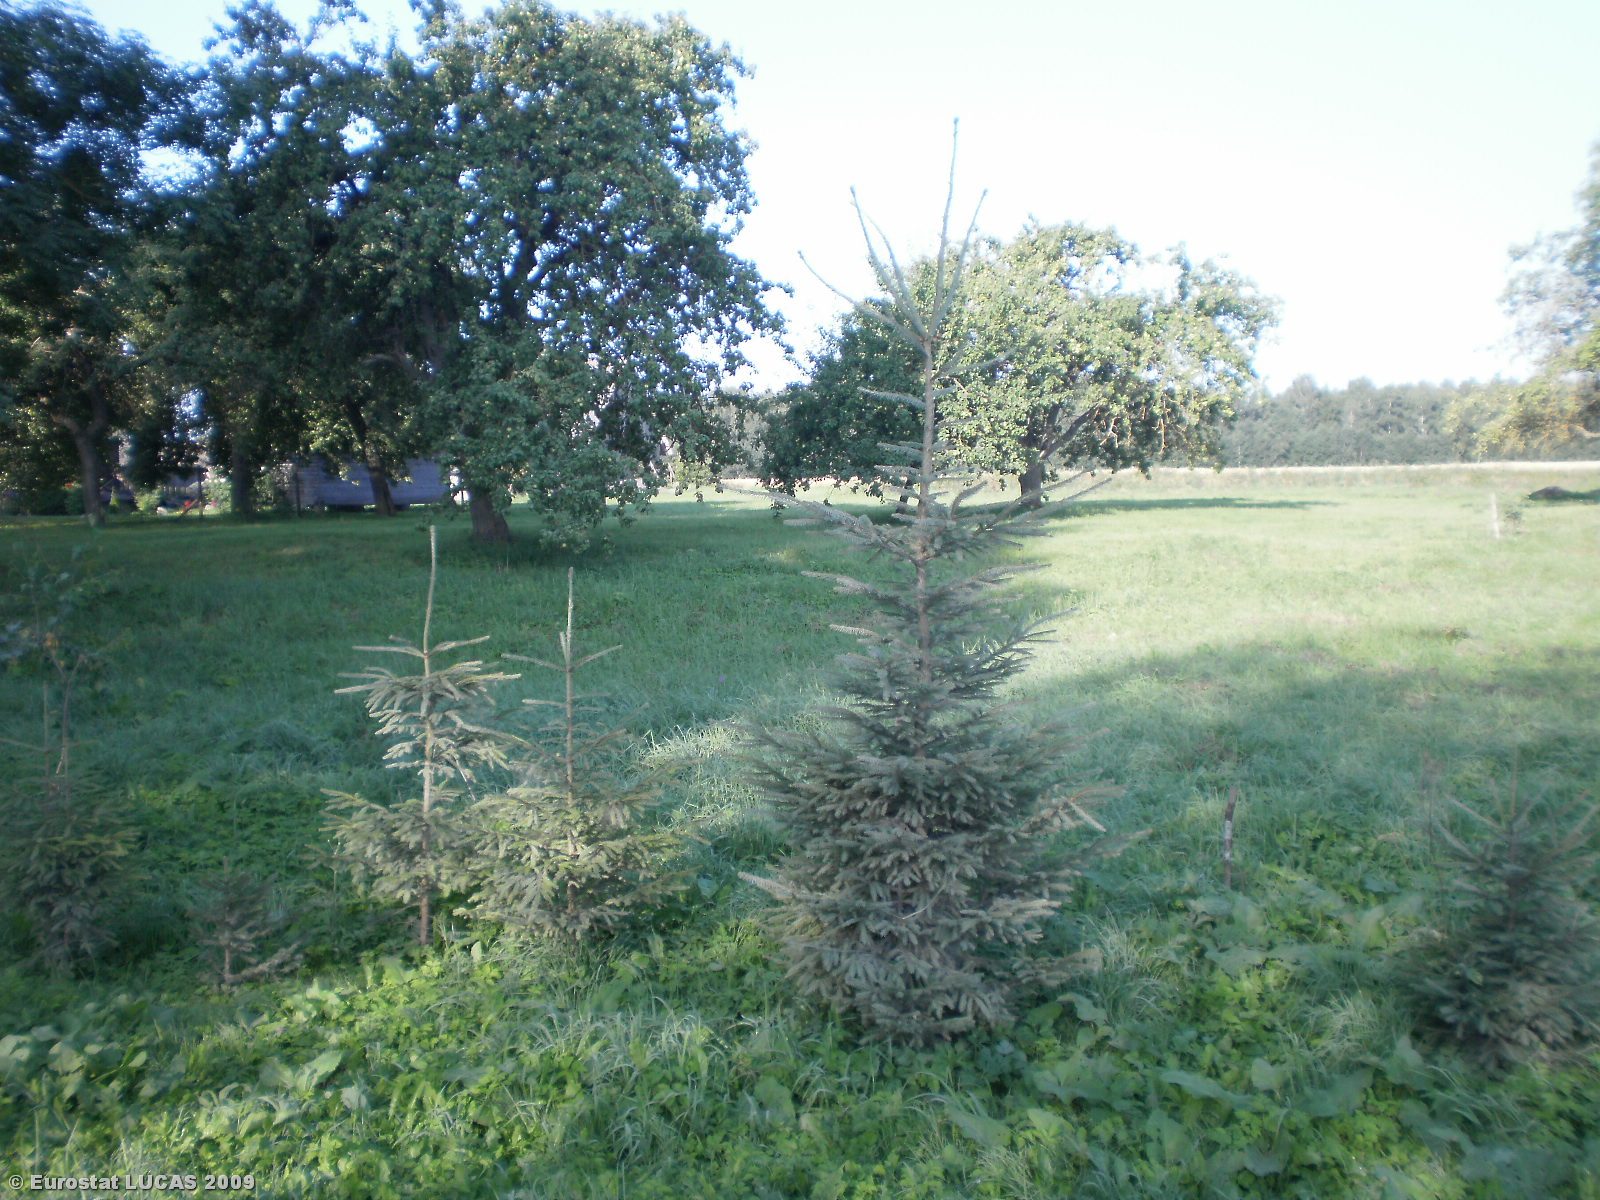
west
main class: Grassland
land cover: Grassland with sparse tree/shrub cover
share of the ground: > 75 %
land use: Residential
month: August
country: LT
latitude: 55.5243
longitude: 24.9531
